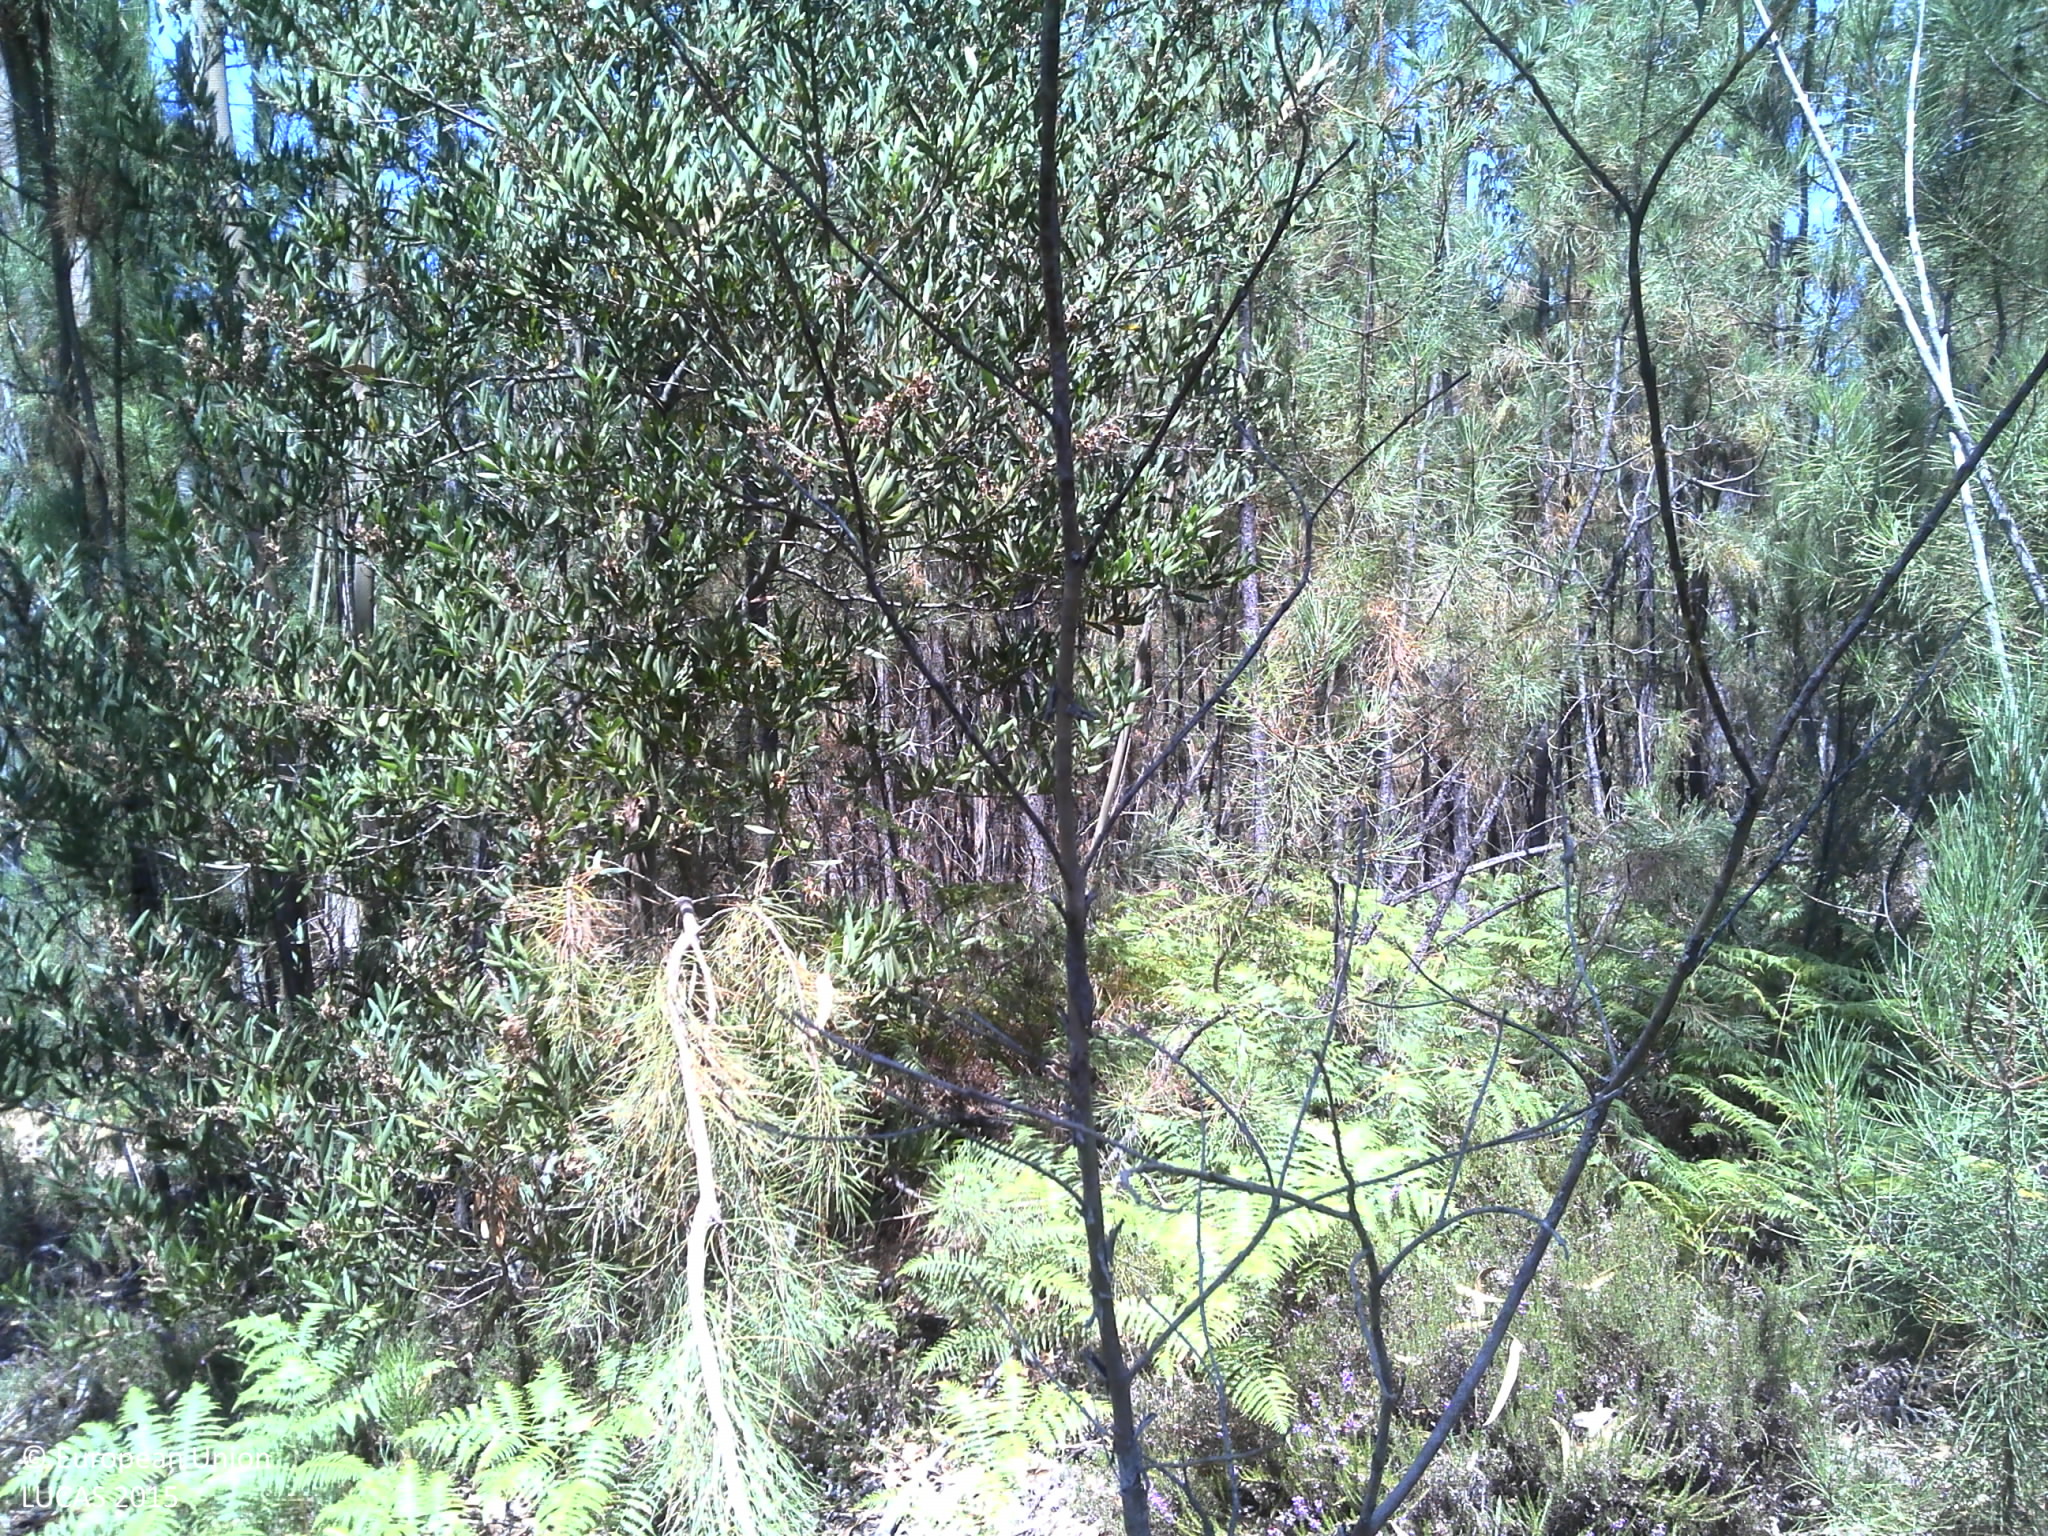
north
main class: Woodland
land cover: Pine dominated mixed woodland
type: coniferous forest of the mediterranean region
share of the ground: 50 - 75 %
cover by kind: coniferous forest trees 50 %, broadleaved forest trees 25 %, shrubs 25 %
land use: Forestry
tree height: > 5 m
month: July
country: PT
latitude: 39.9883
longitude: -8.6000
